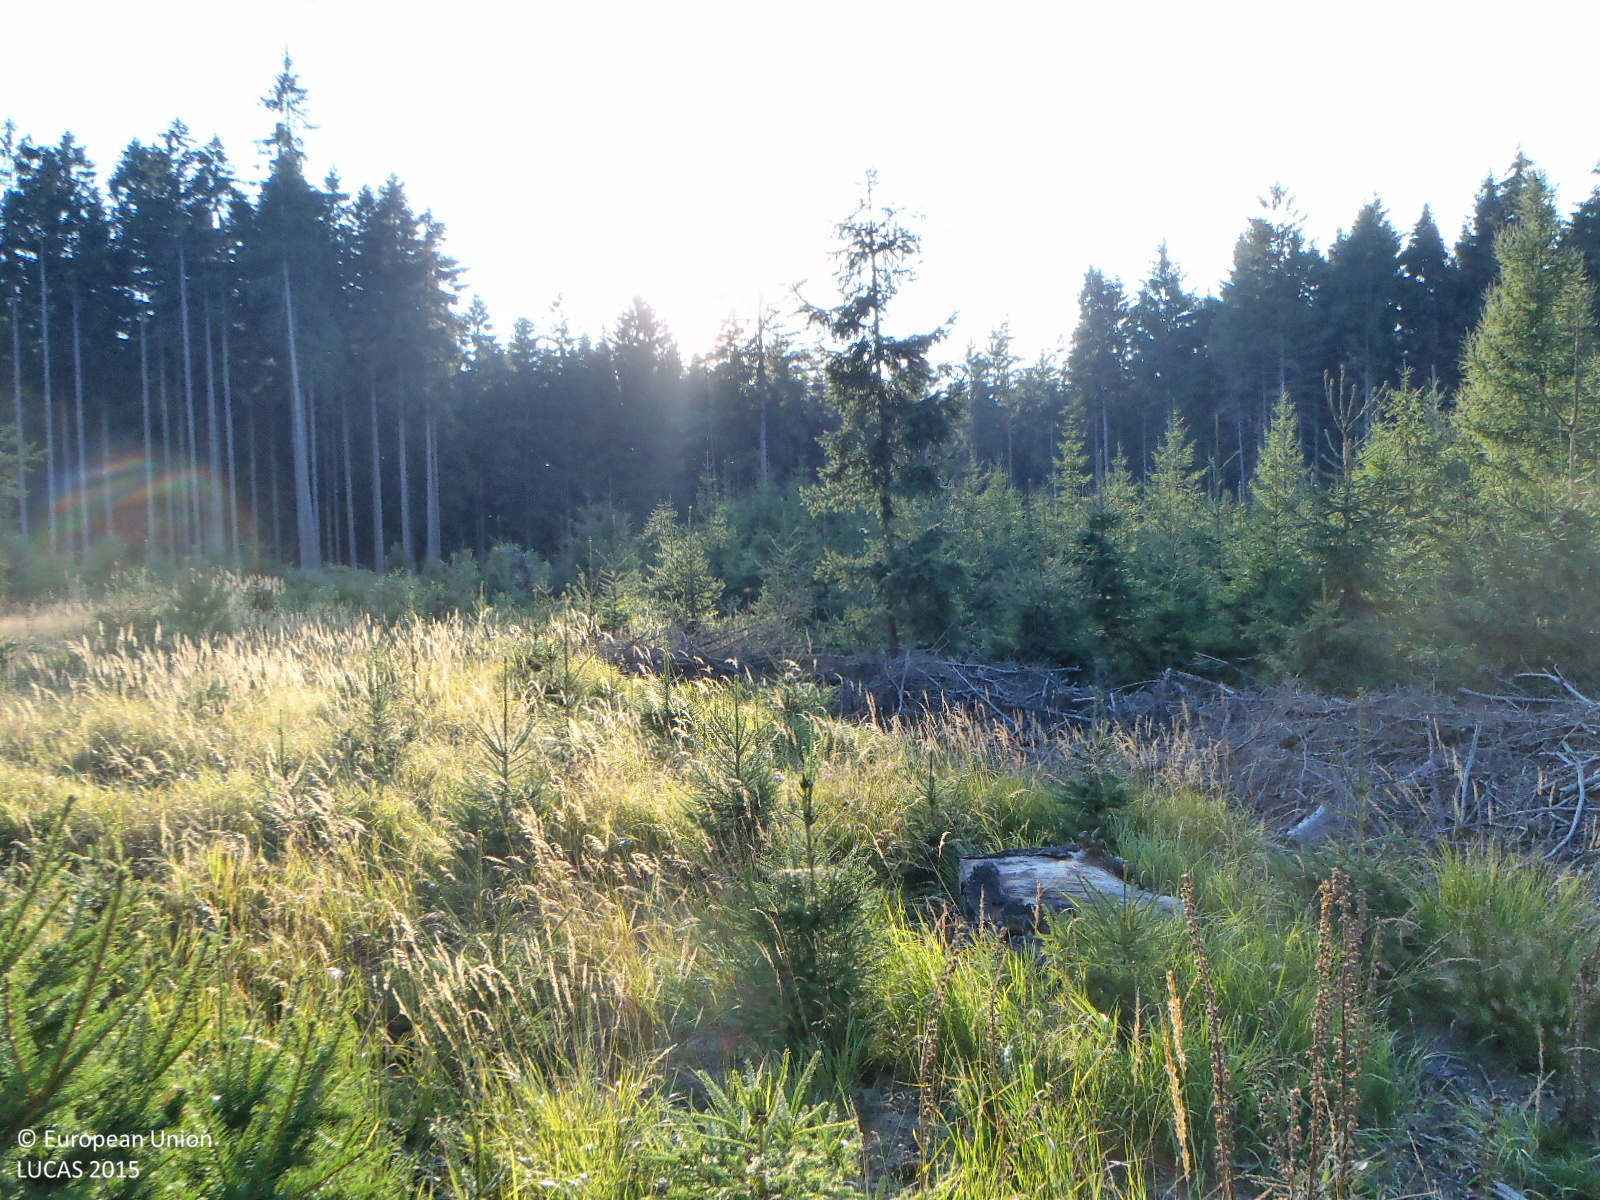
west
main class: Woodland
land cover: Other mixed woodland
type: hemiboreal forest and nemoral coniferous forest and mixed broadleaved-coniferous forest
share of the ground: 50 - 75 %
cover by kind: herbaceous plants 45 %, coniferous forest trees 25 %, broadleaved forest trees 25 %, shrubs 5 %
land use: Forestry
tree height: < 5 m
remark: Nursery
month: August
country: CZ
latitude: 50.8685
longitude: 14.5347
